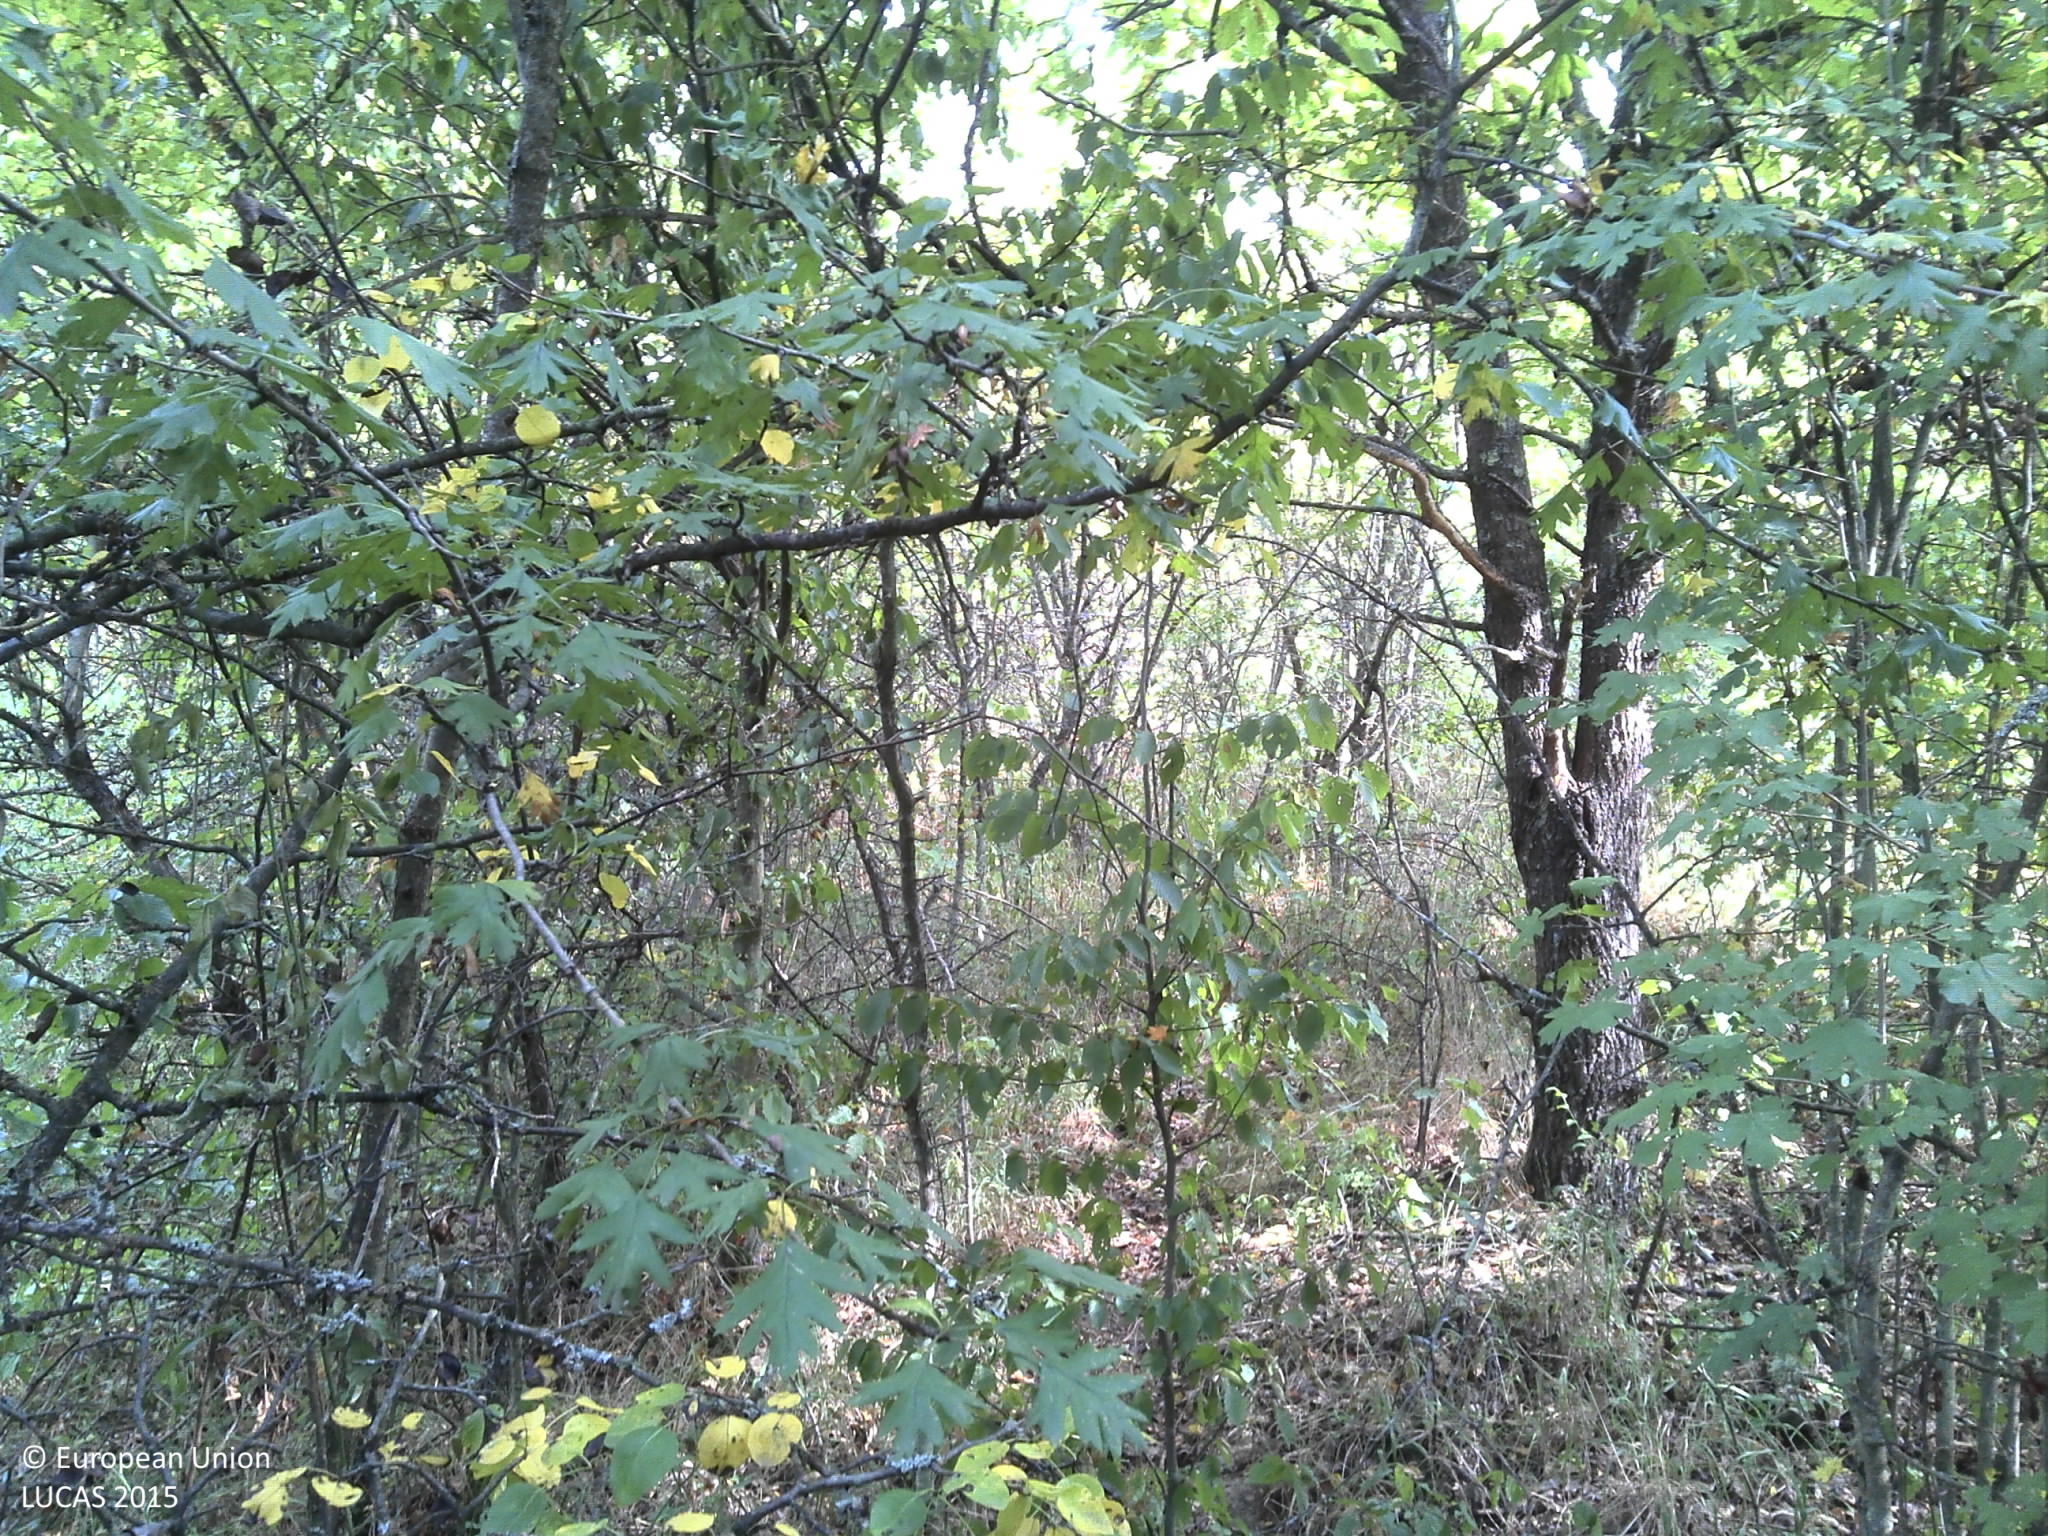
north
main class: Shrubland
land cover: Shrubland with sparse tree cover
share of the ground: > 75 %
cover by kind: shrubs 95 %, broadleaved forest trees 5 %
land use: Semi-natural and natural areas not in use
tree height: < 5 m
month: August
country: HR
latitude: 45.2935
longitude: 18.2029
